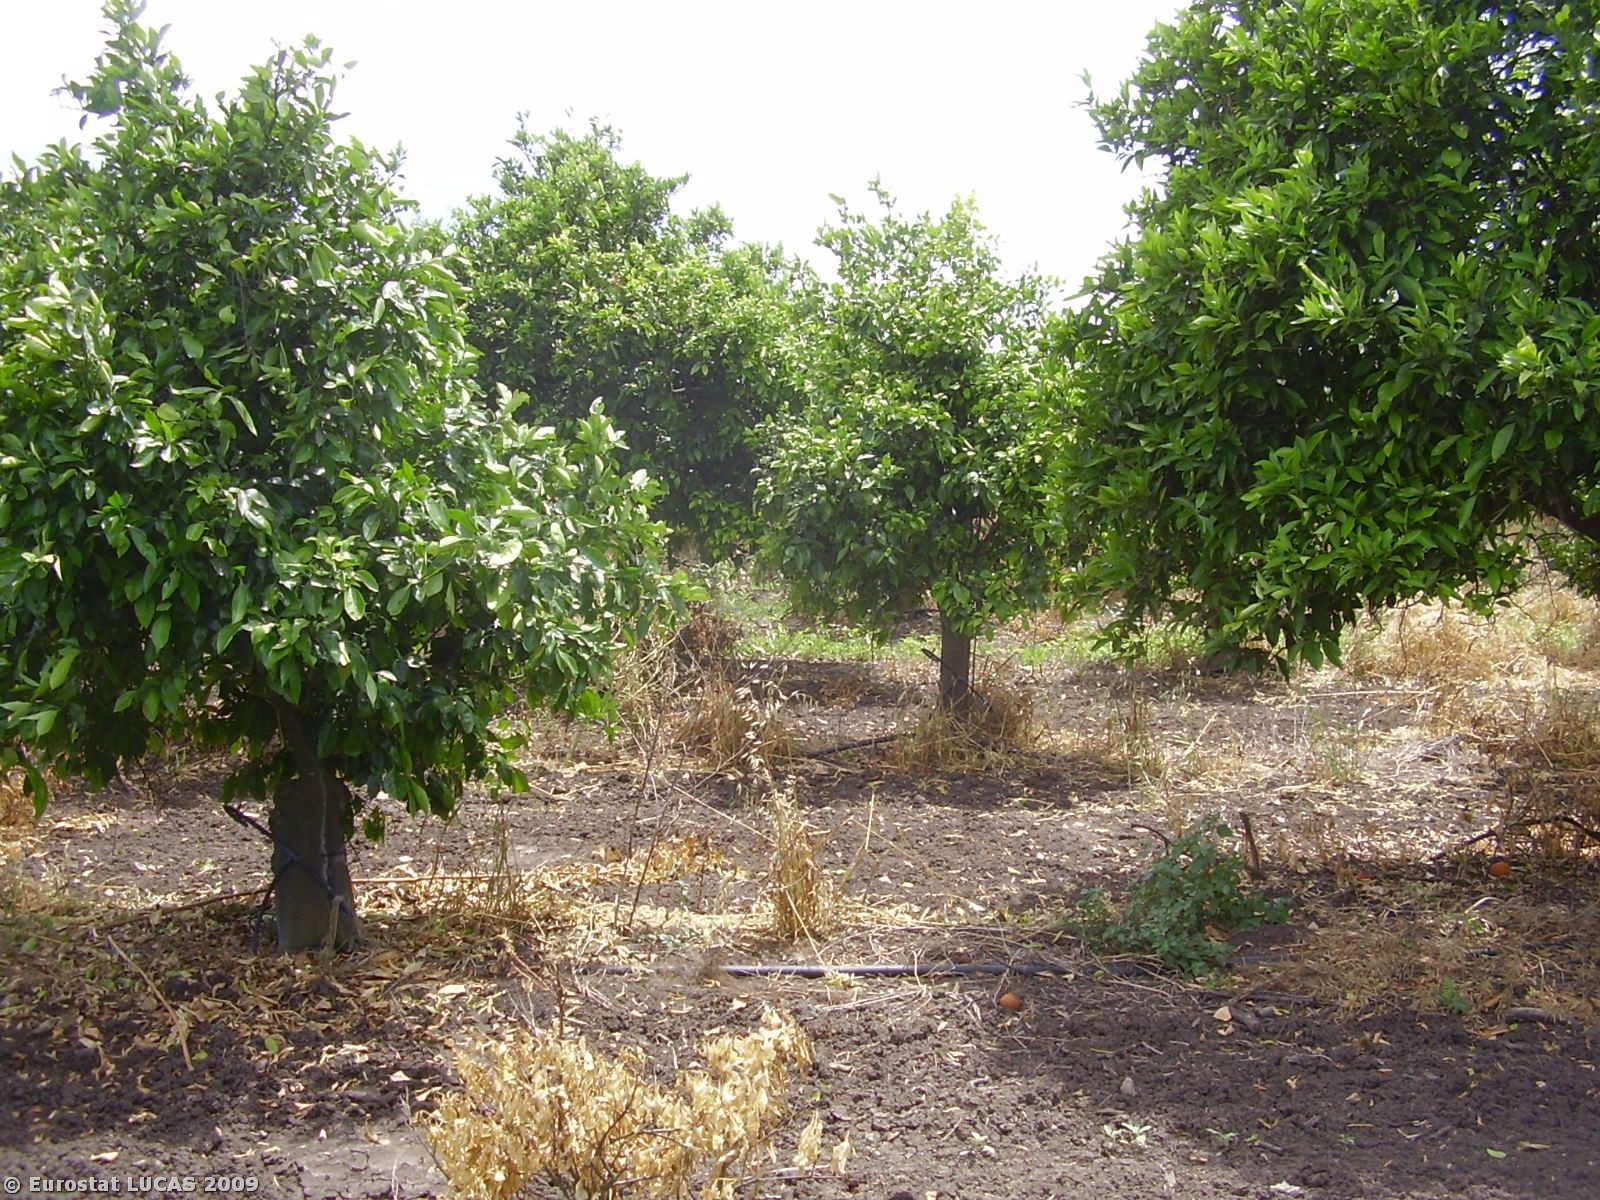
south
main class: Cropland
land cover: Oranges
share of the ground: 50 - 75 %
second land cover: Bare land
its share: > 75 %
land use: Agriculture (excluding fallow land and kitchen gardens)
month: June
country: IT
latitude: 37.2930
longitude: 14.9154
